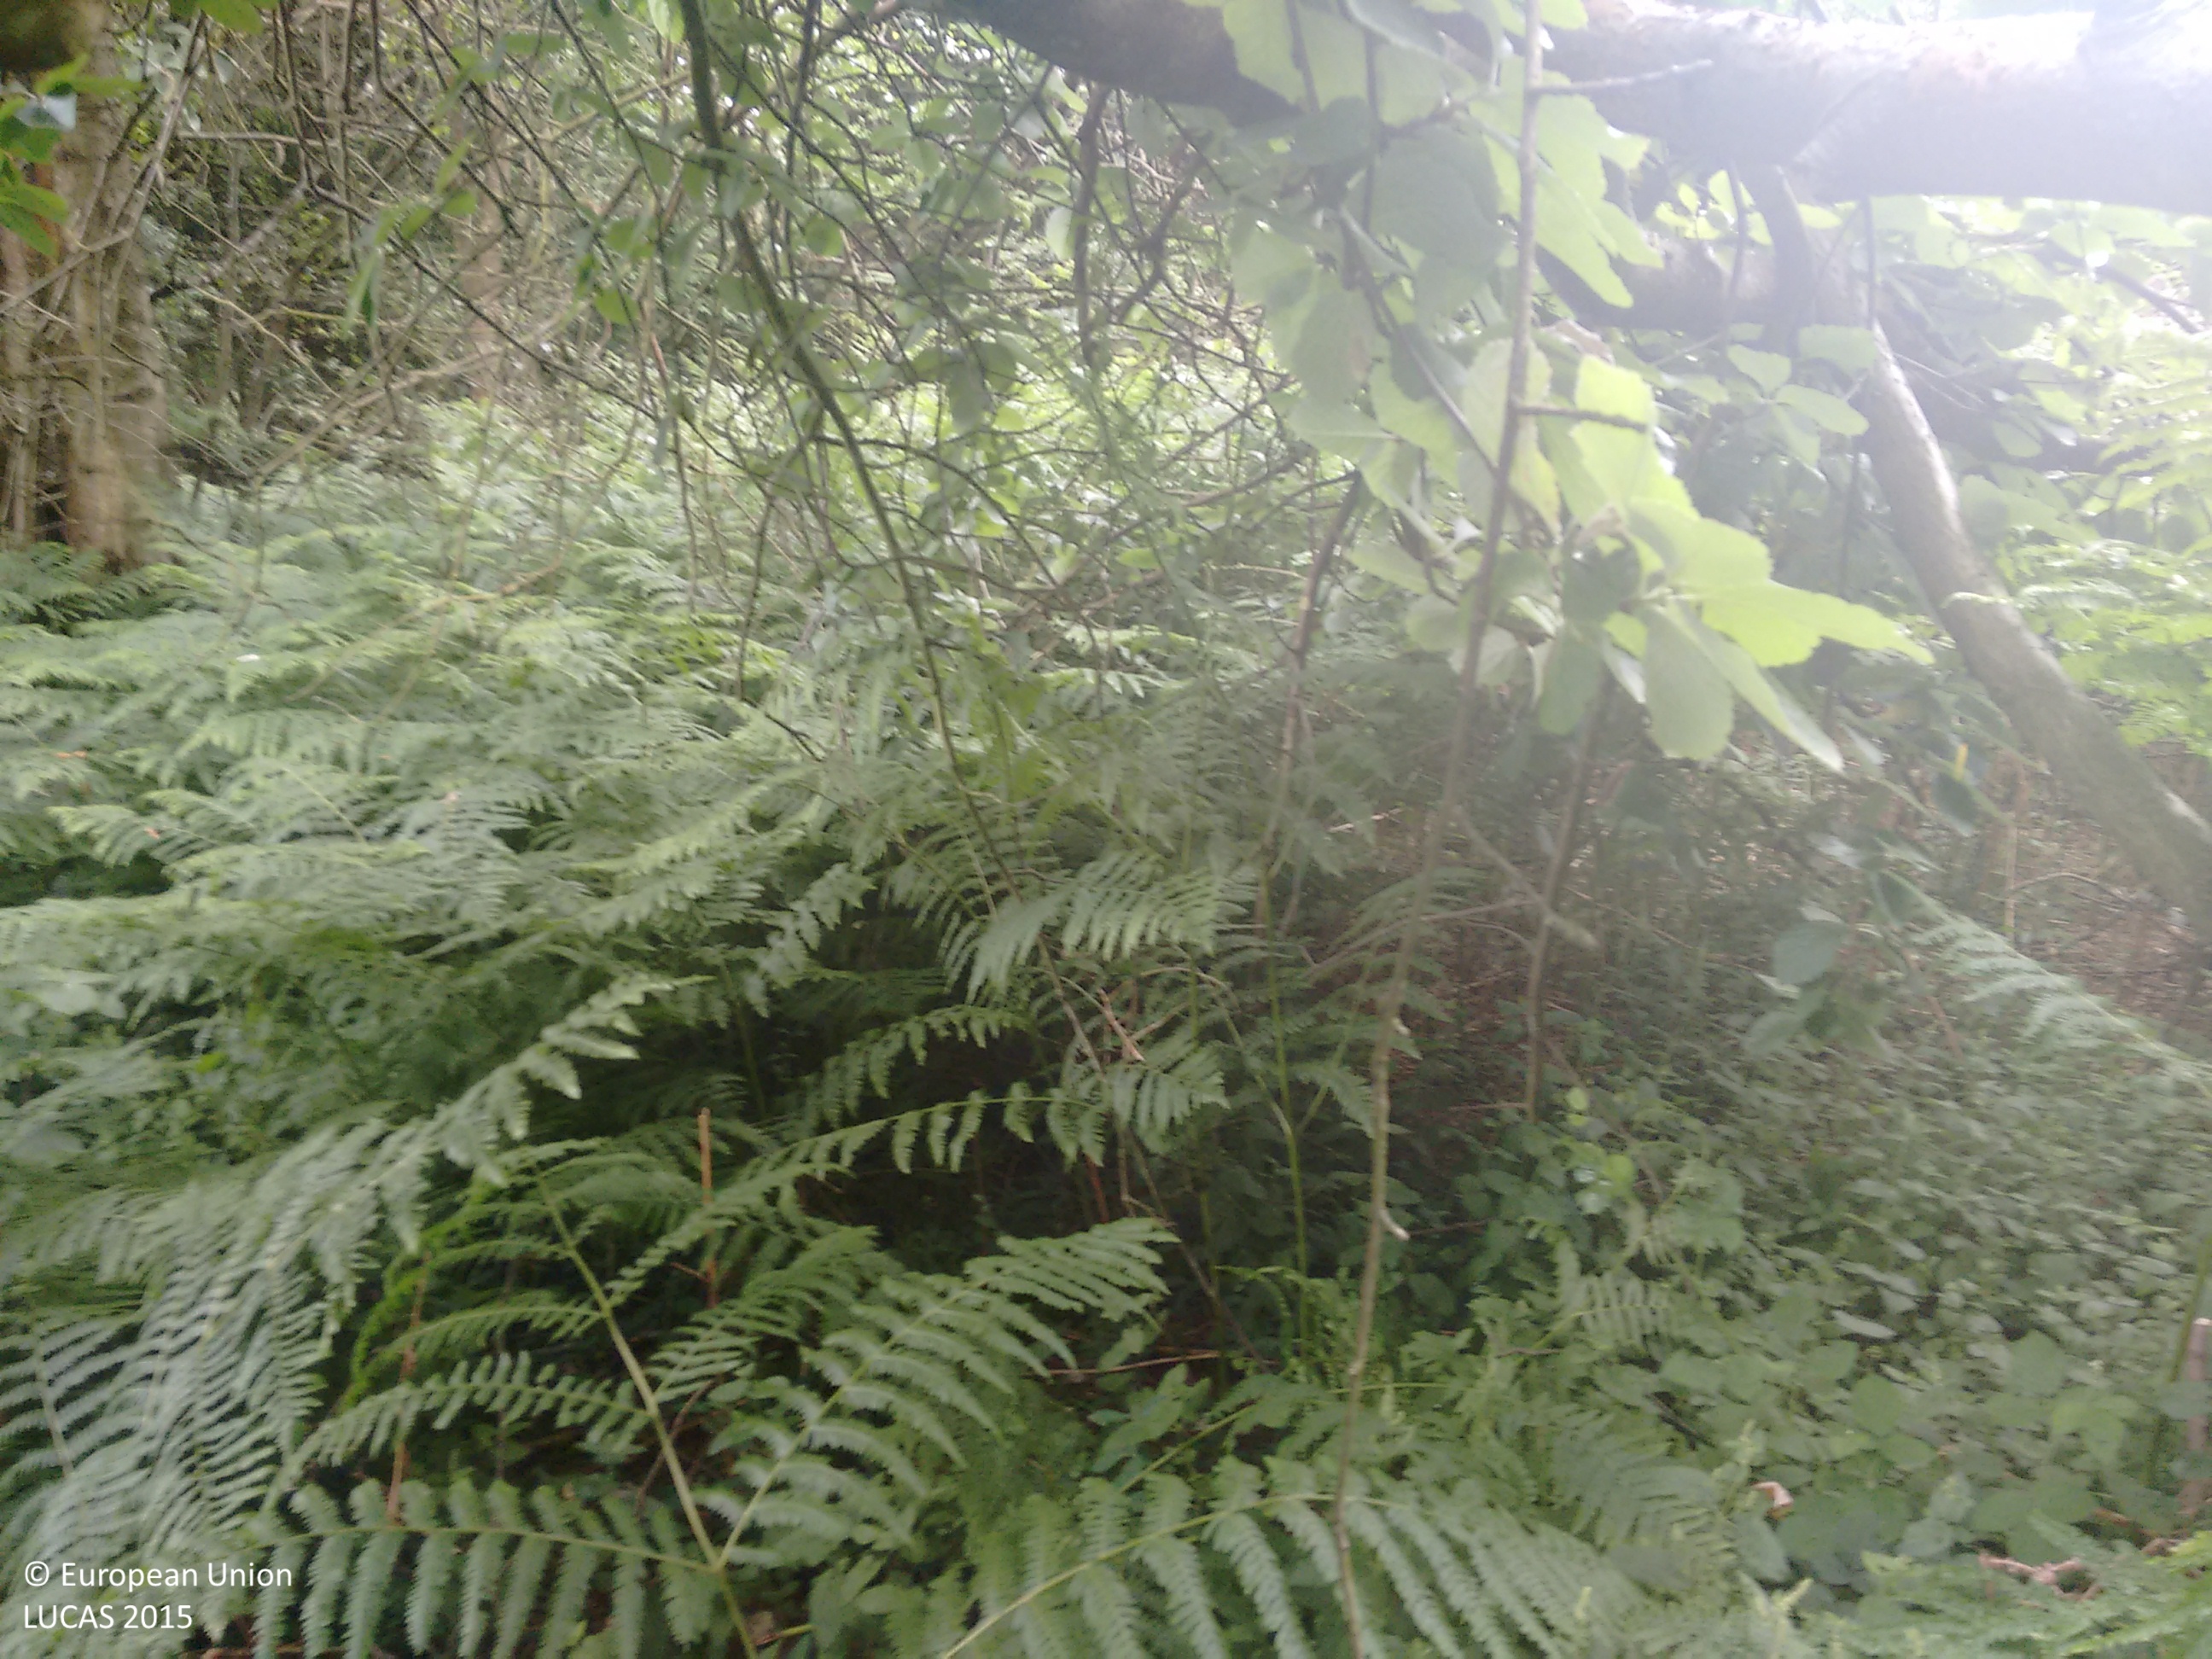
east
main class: Woodland
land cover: Other mixed woodland
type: mesophytic deciduous forest
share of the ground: > 75 %
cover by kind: broadleaved forest trees 60 %, coniferous forest trees 40 %
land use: Forestry
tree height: > 5 m
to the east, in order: Other mixed woodland; Tracks; Other mixed woodland; Broadleaved woodland; Paved roads, cycling and walking lanes; Broadleaved woodland
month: July
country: GB
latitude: 51.2387
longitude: -0.5090
